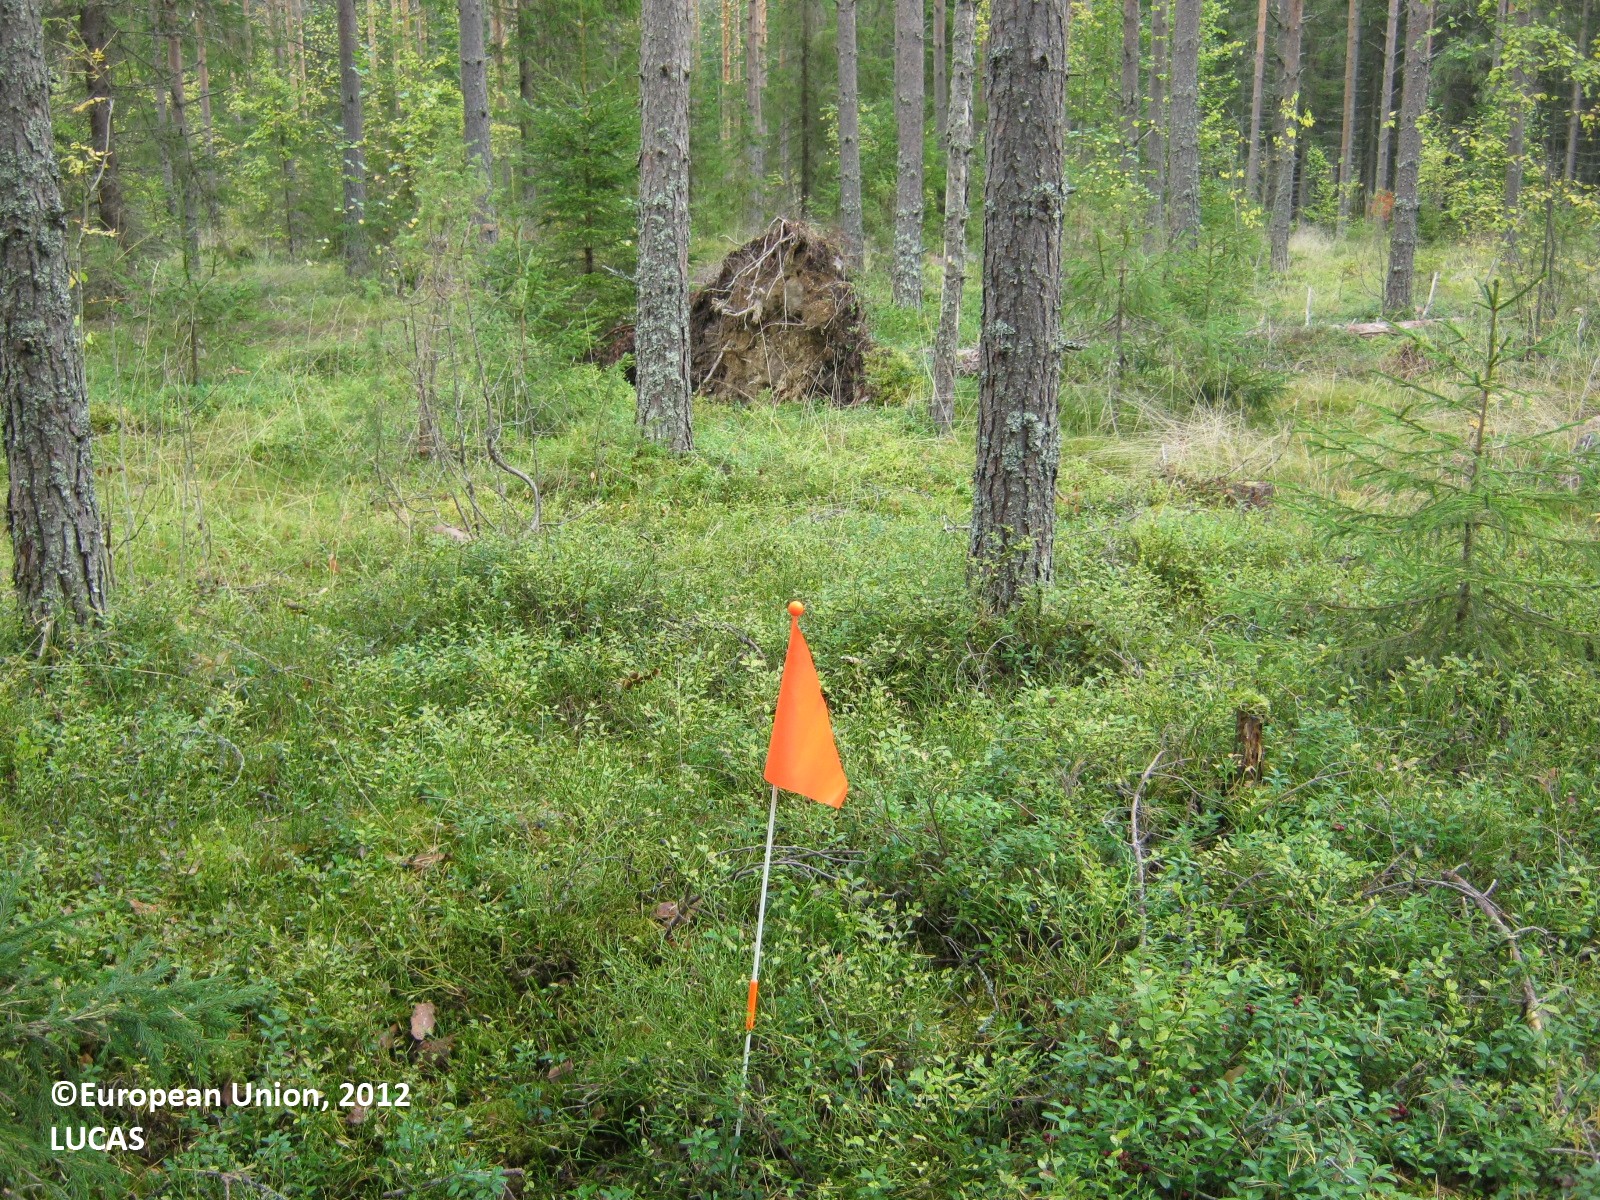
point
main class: Woodland
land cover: Pine dominated coniferous woodland
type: boreal forest
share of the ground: 50 - 75 %
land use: Forestry
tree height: > 5 m
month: September
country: FI
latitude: 60.8525
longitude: 28.0747
